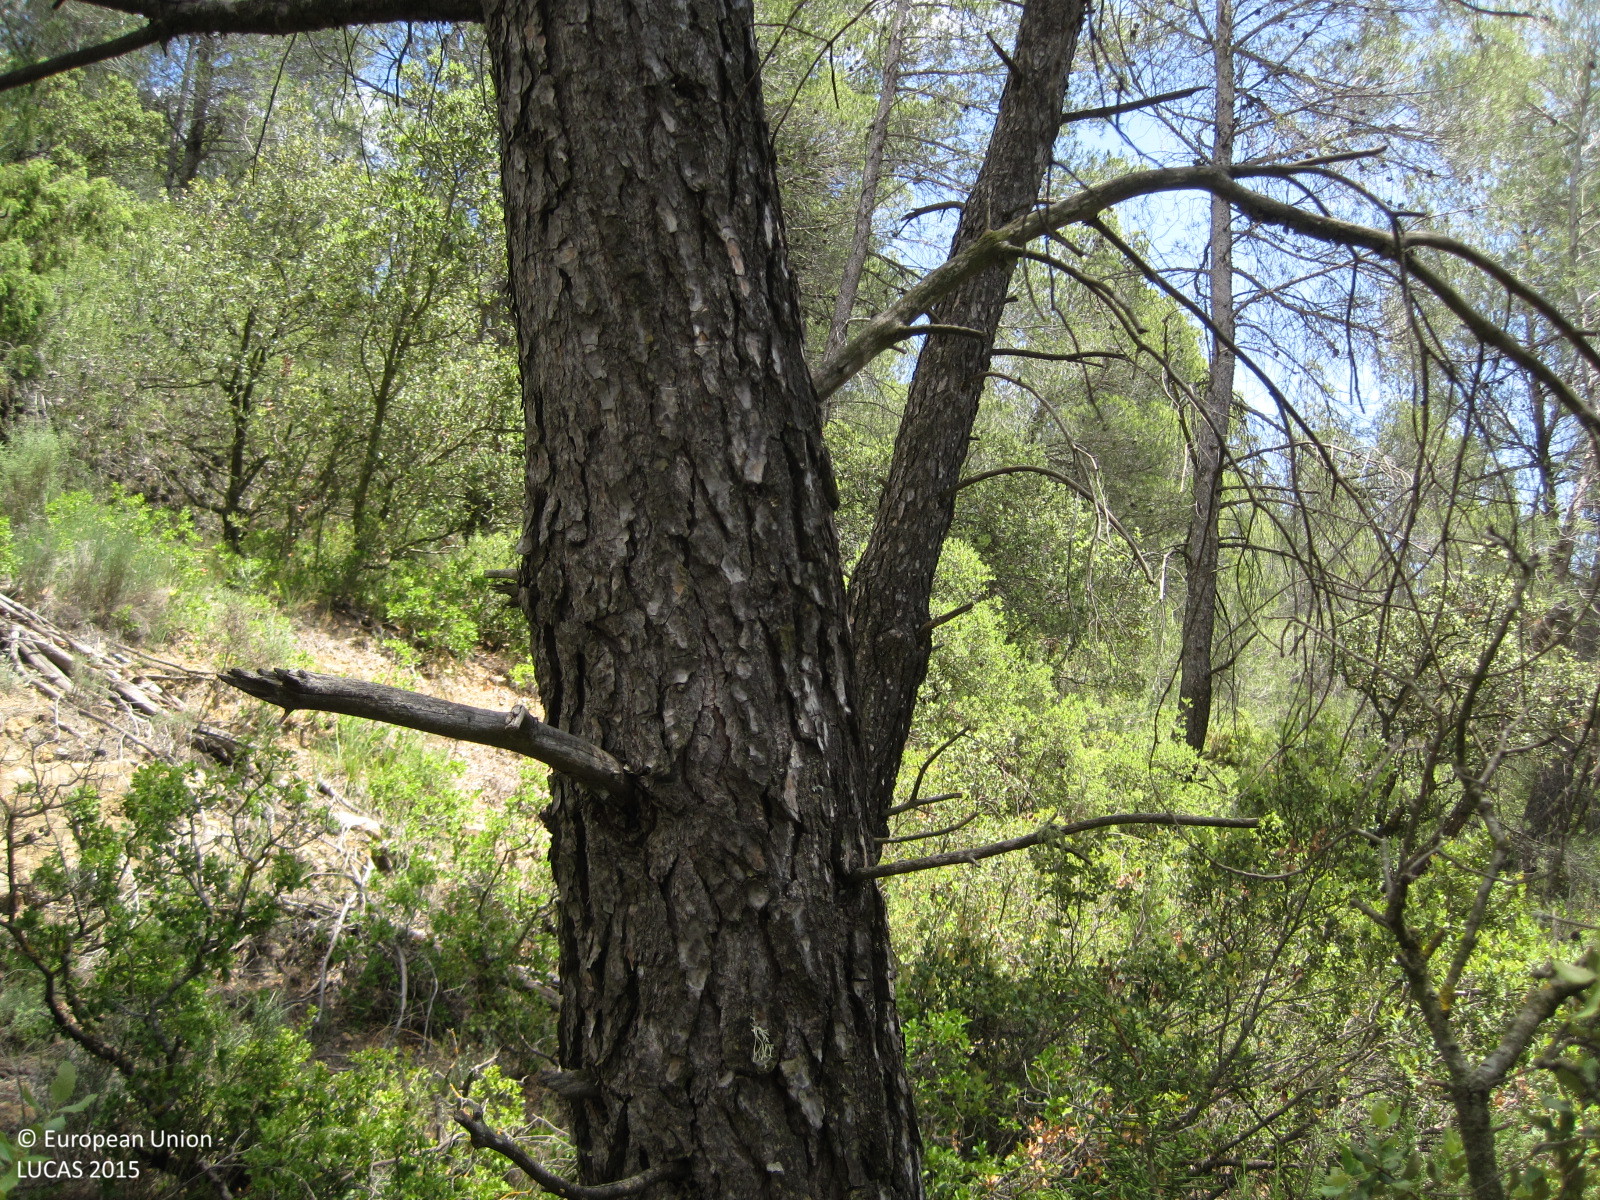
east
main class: Woodland
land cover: Pine dominated coniferous woodland
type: coniferous forest of the mediterranean region
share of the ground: 50 - 75 %
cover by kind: coniferous forest trees 60 %, shrubs 20 %, broadleaved forest trees 15 %, herbaceous plants 5 %
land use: Forestry
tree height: > 5 m
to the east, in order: Pine dominated coniferous woodland
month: May
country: ES
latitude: 39.5988
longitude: -1.1006
